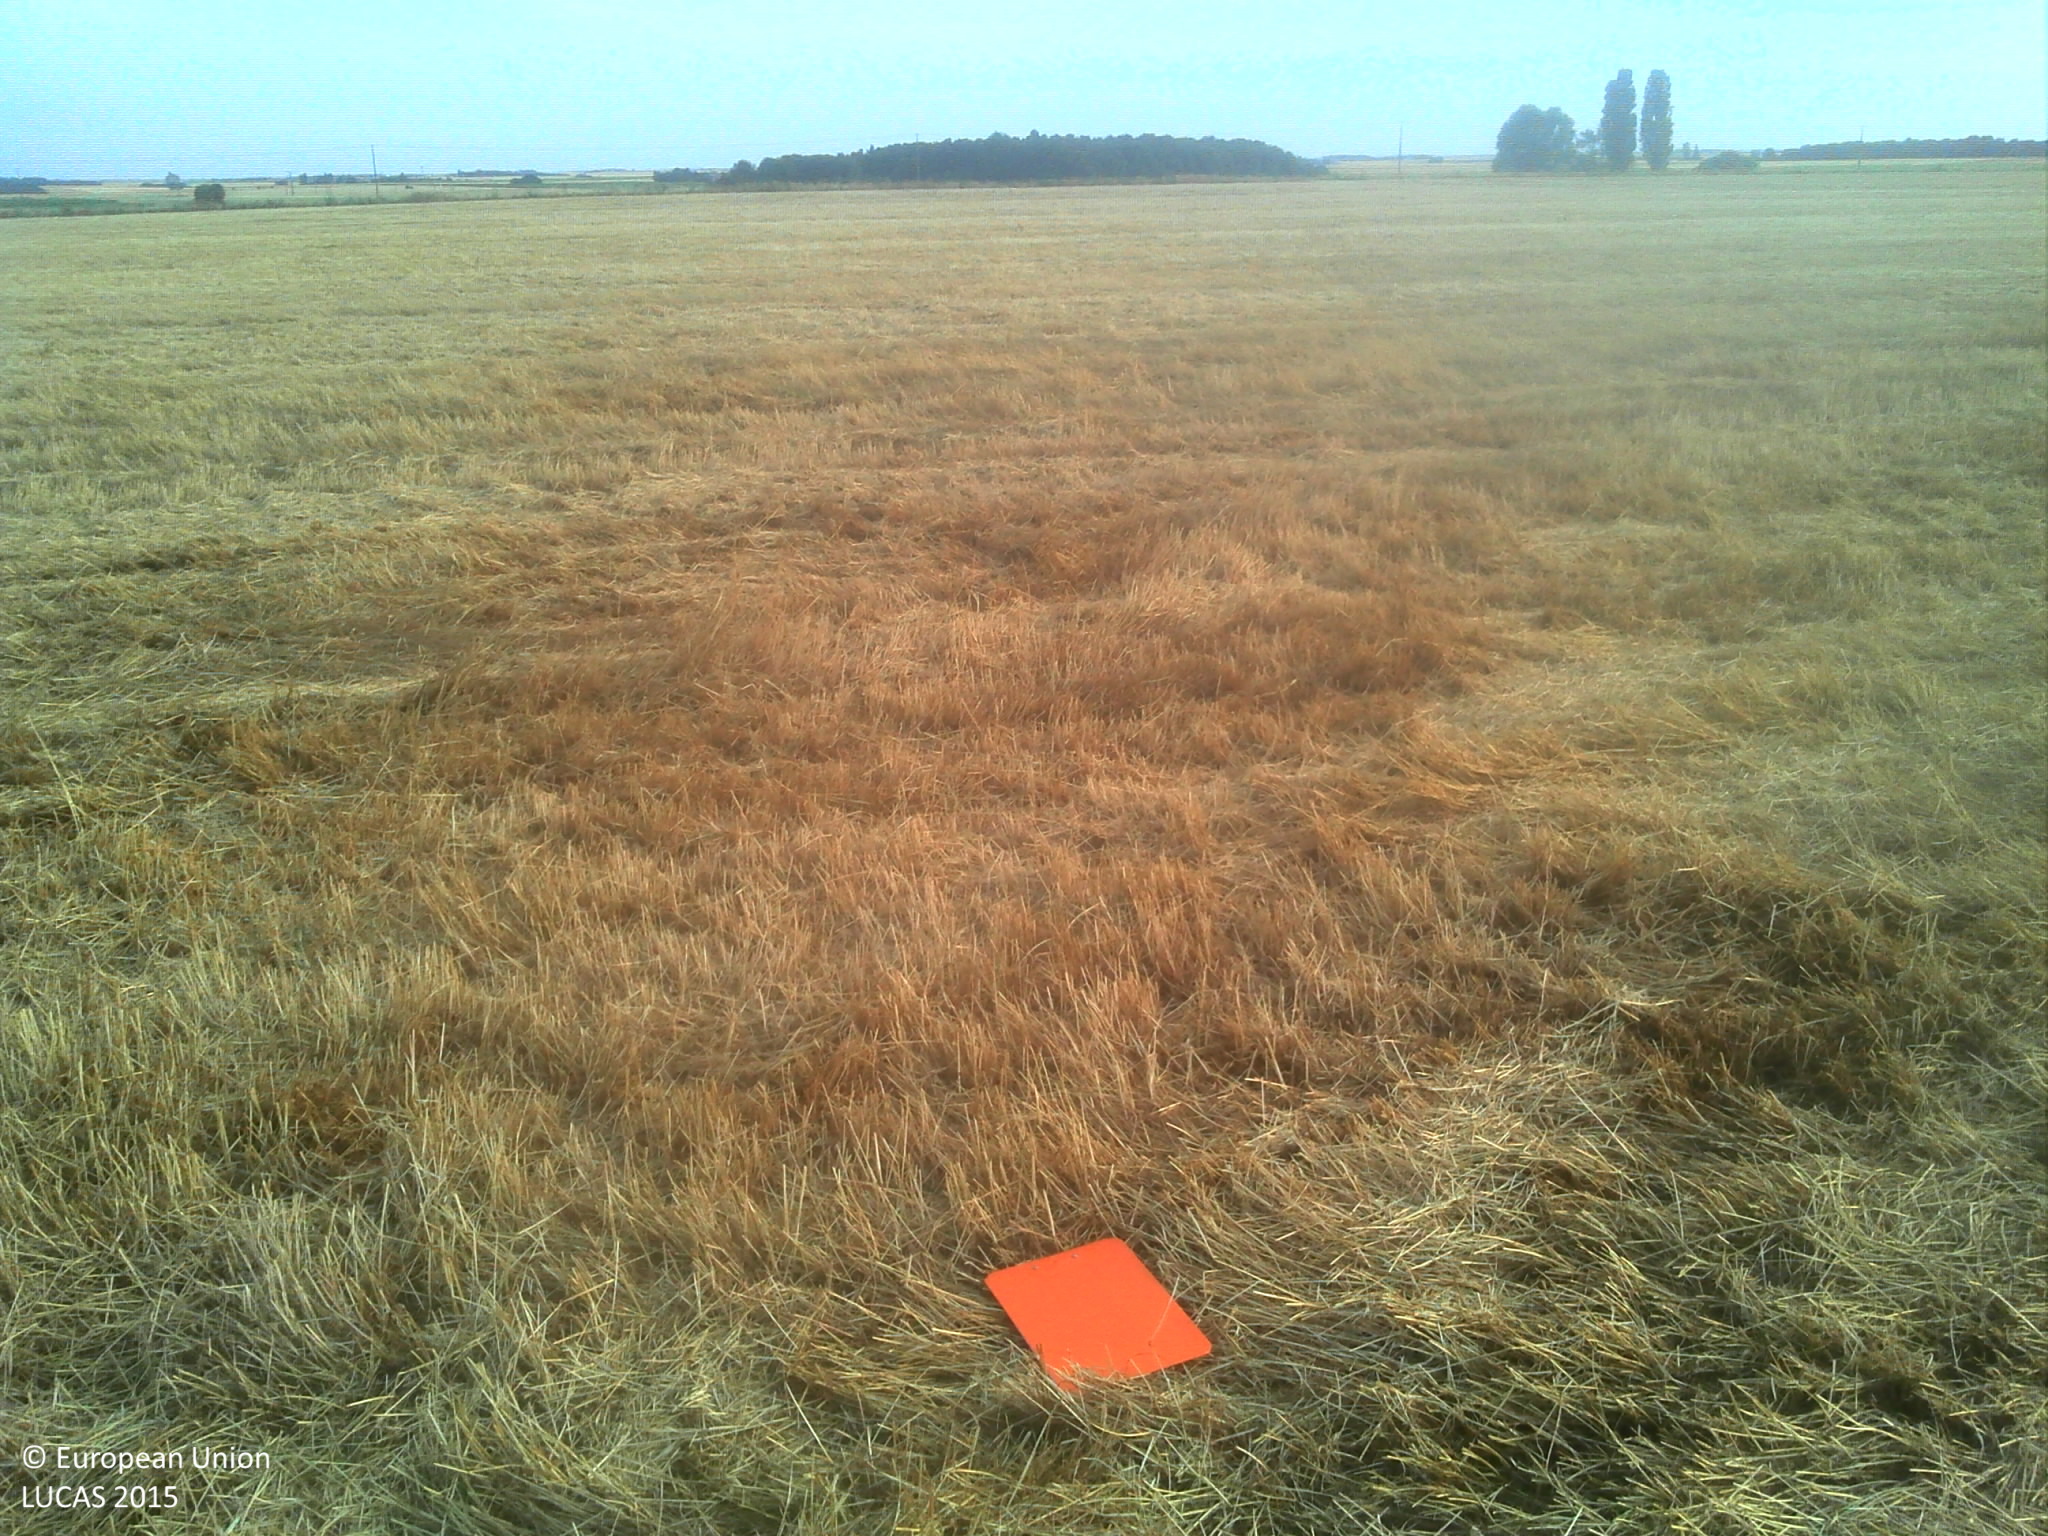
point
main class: Cropland
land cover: Durum wheat
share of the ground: > 75 %
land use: Agriculture (excluding fallow land and kitchen gardens)
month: July
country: FR
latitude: 47.8165
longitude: 1.4237
